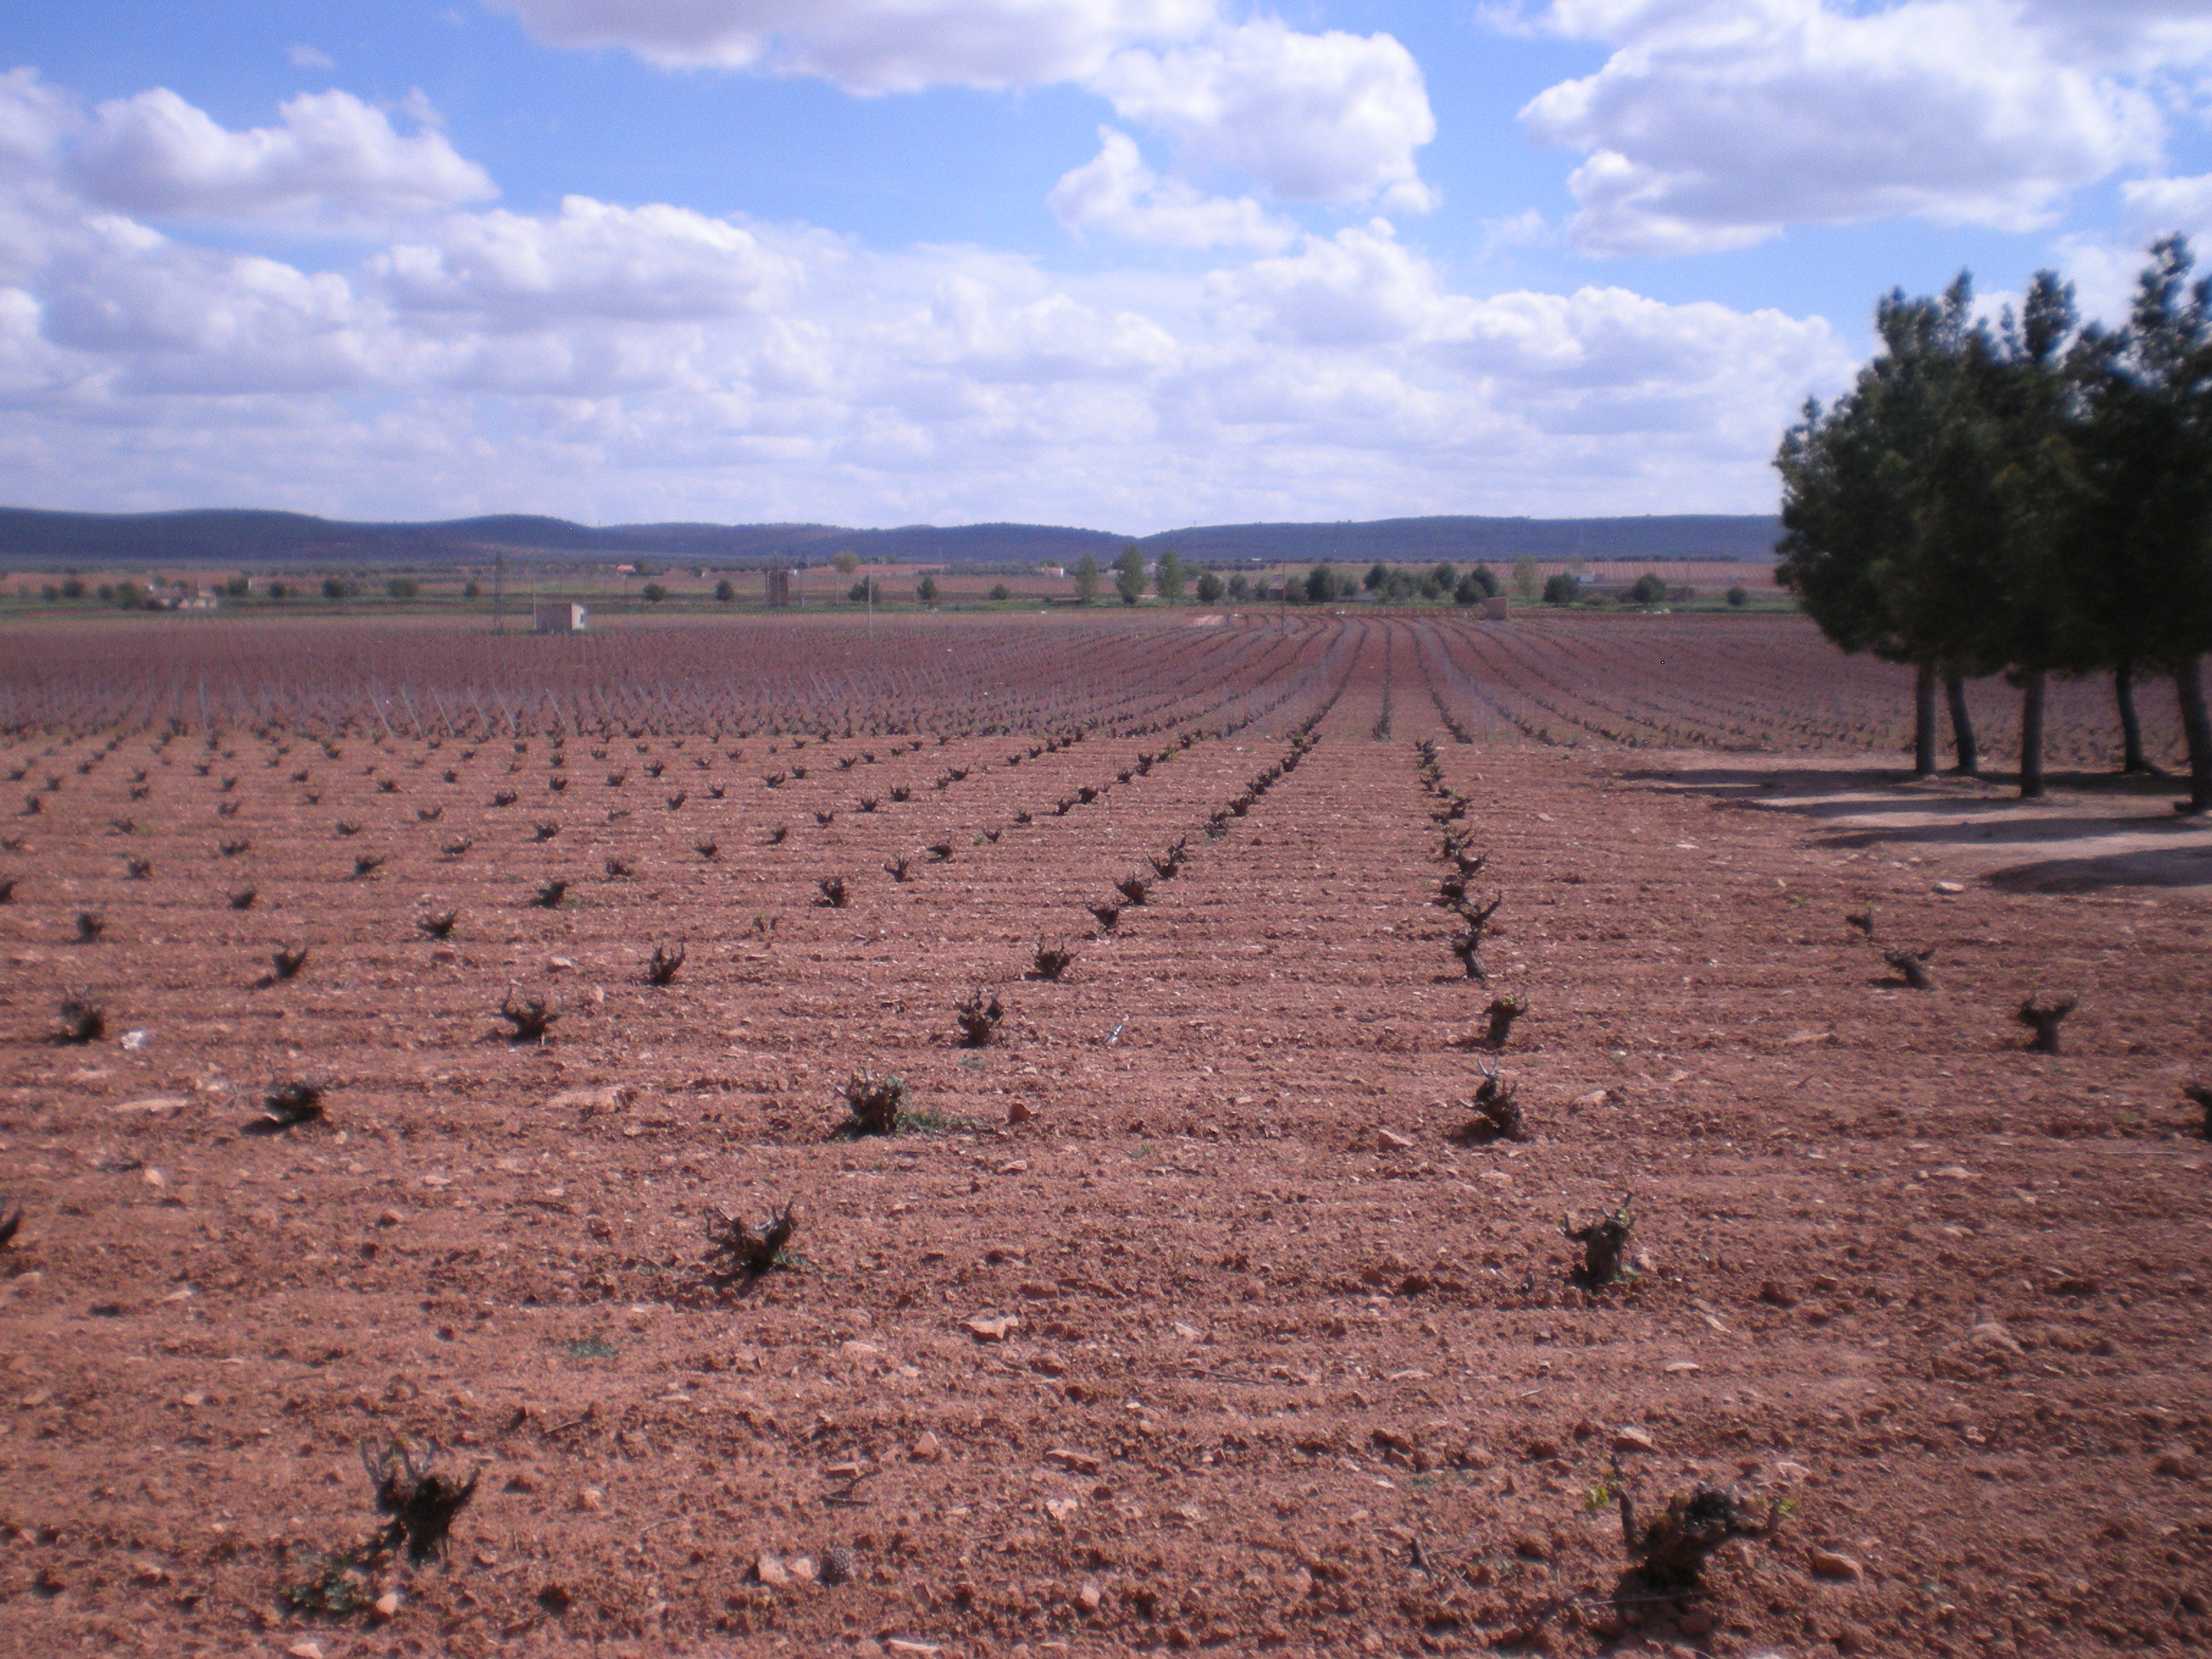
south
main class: Cropland
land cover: Vineyards
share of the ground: < 10 %
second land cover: Other bare soil
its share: > 75 %
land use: Agriculture (excluding fallow land and kitchen gardens)
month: April
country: ES
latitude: 38.7891
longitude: -3.5637
